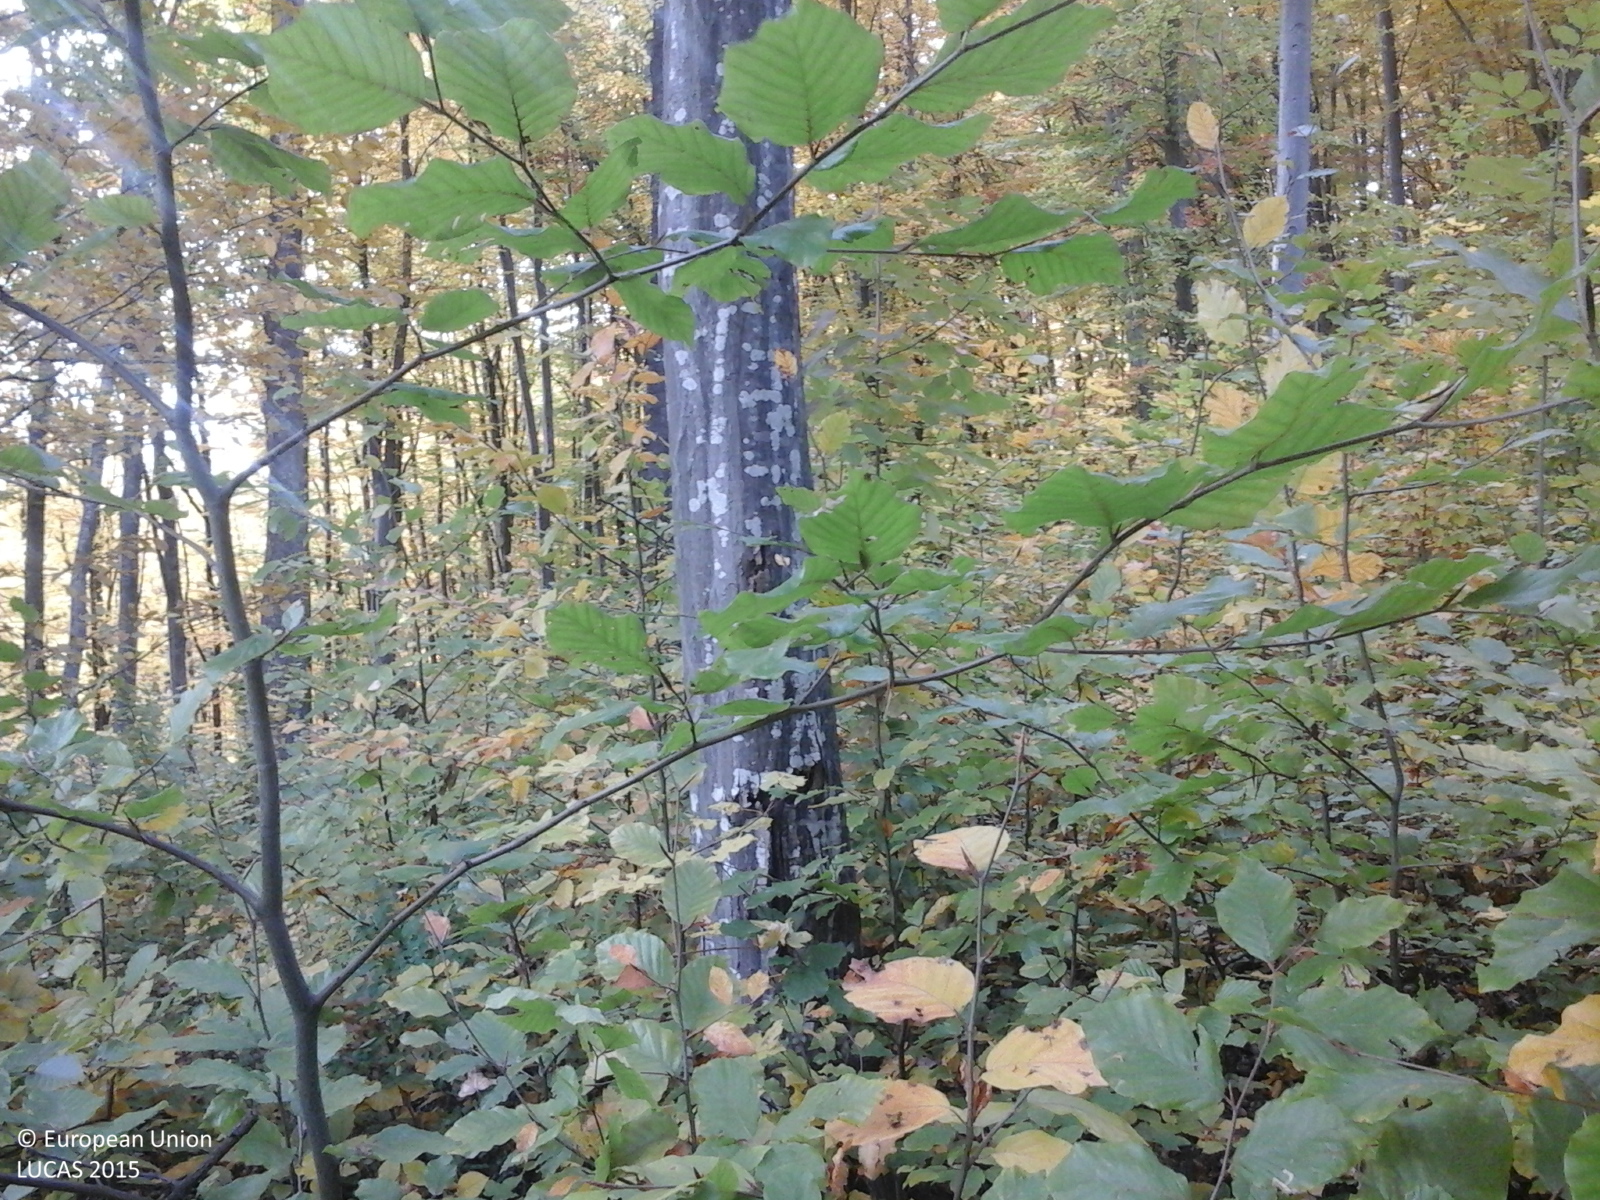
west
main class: Woodland
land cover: Broadleaved woodland
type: beech forest
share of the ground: > 75 %
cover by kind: broadleaved forest trees 100 %
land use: Forestry
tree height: > 5 m
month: October
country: RO
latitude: 45.5304
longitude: 26.7660
